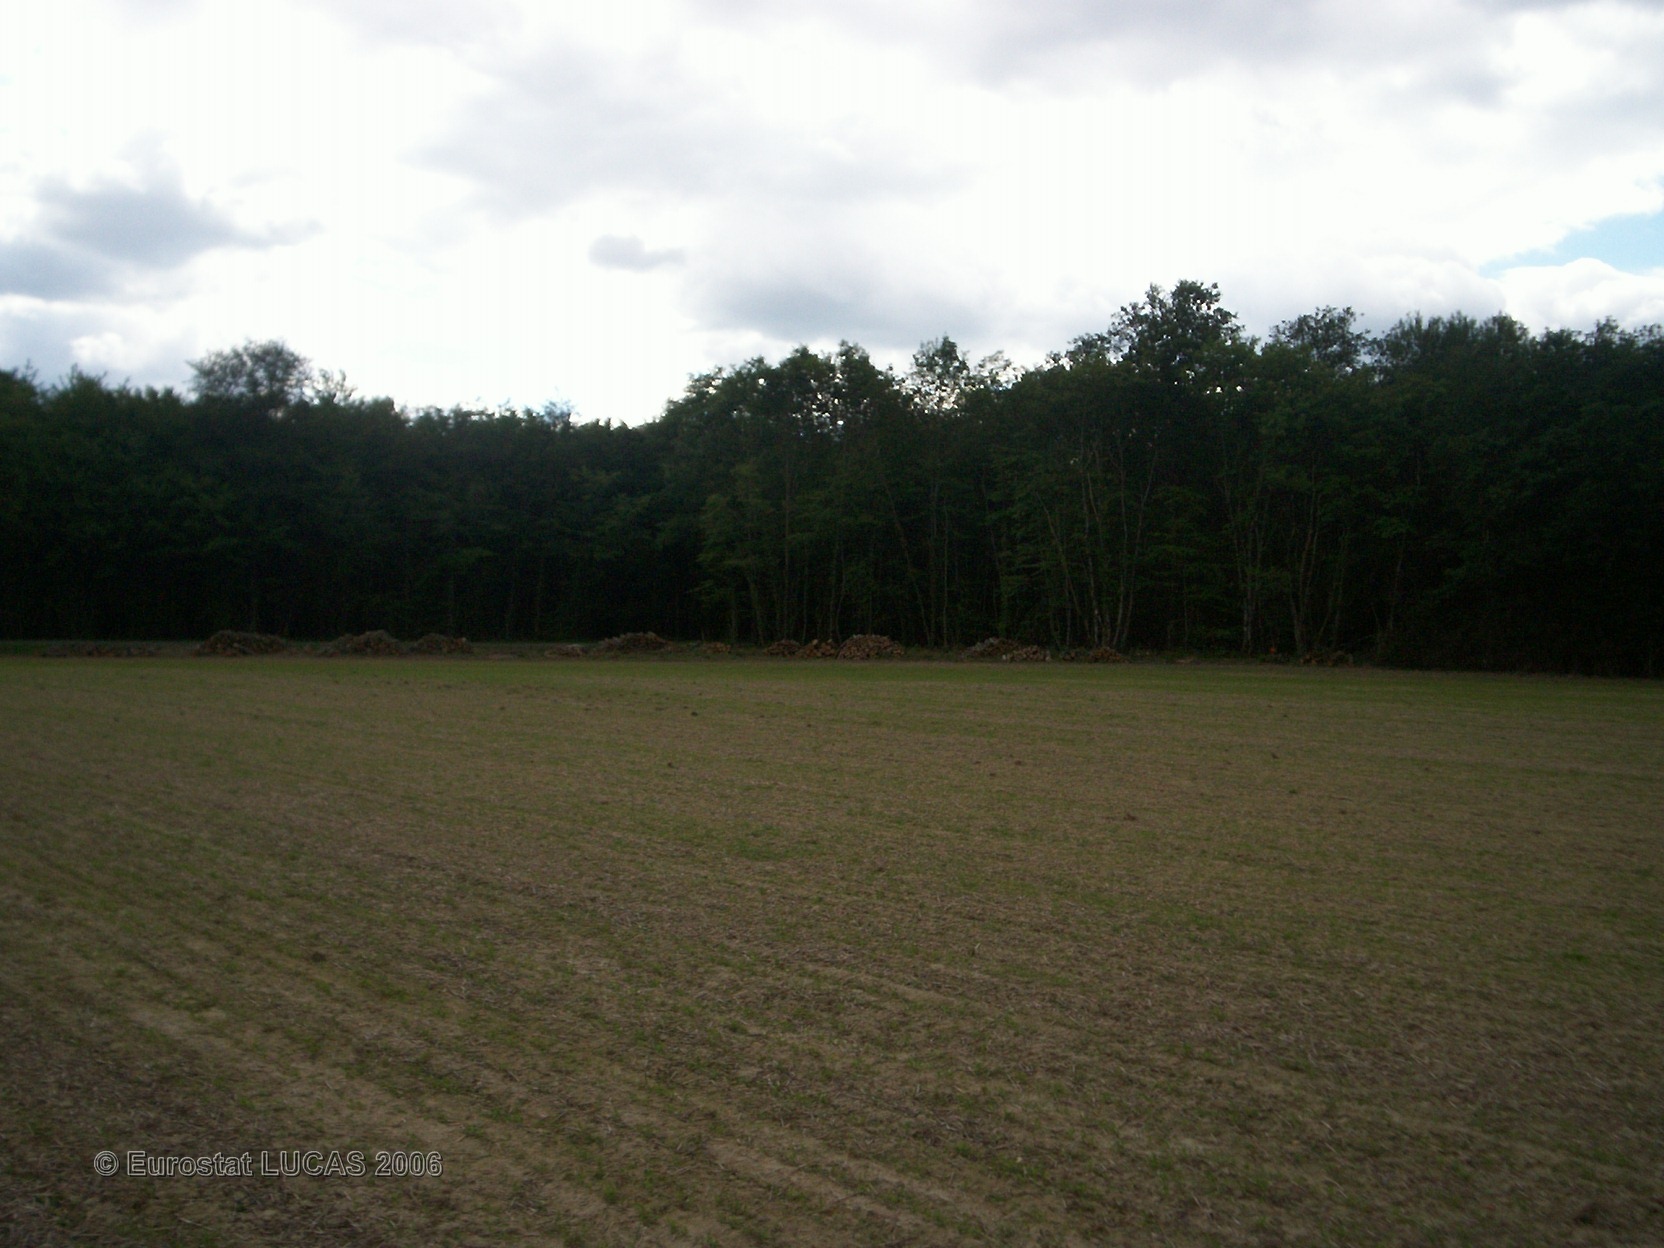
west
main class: Cropland
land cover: Maize
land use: Agriculture (excluding fallow land and kitchen gardens)
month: May
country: FR
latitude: 47.0284
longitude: 1.5273
